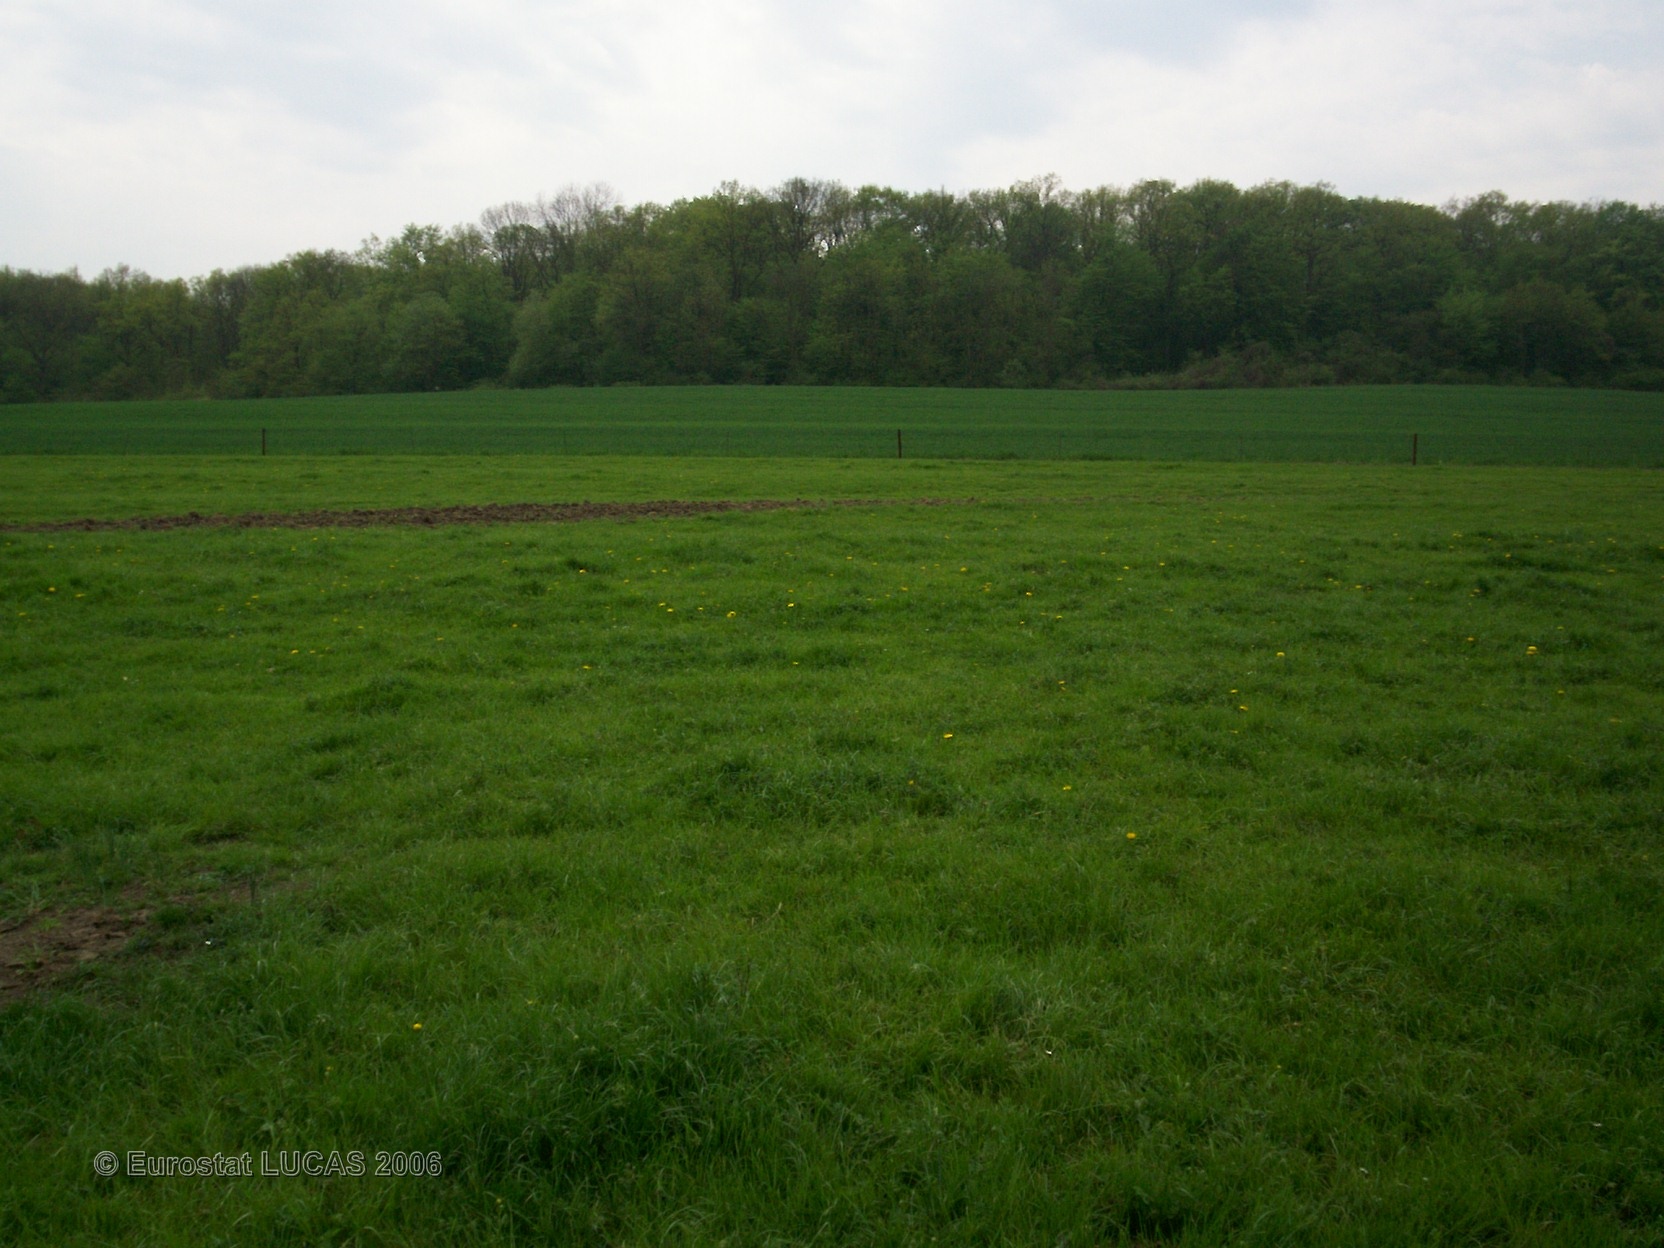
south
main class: Grassland
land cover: Grassland without tree/shrub cover
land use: Agriculture (excluding fallow land and kitchen gardens)
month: May
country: FR
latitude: 49.2287
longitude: 6.4433
